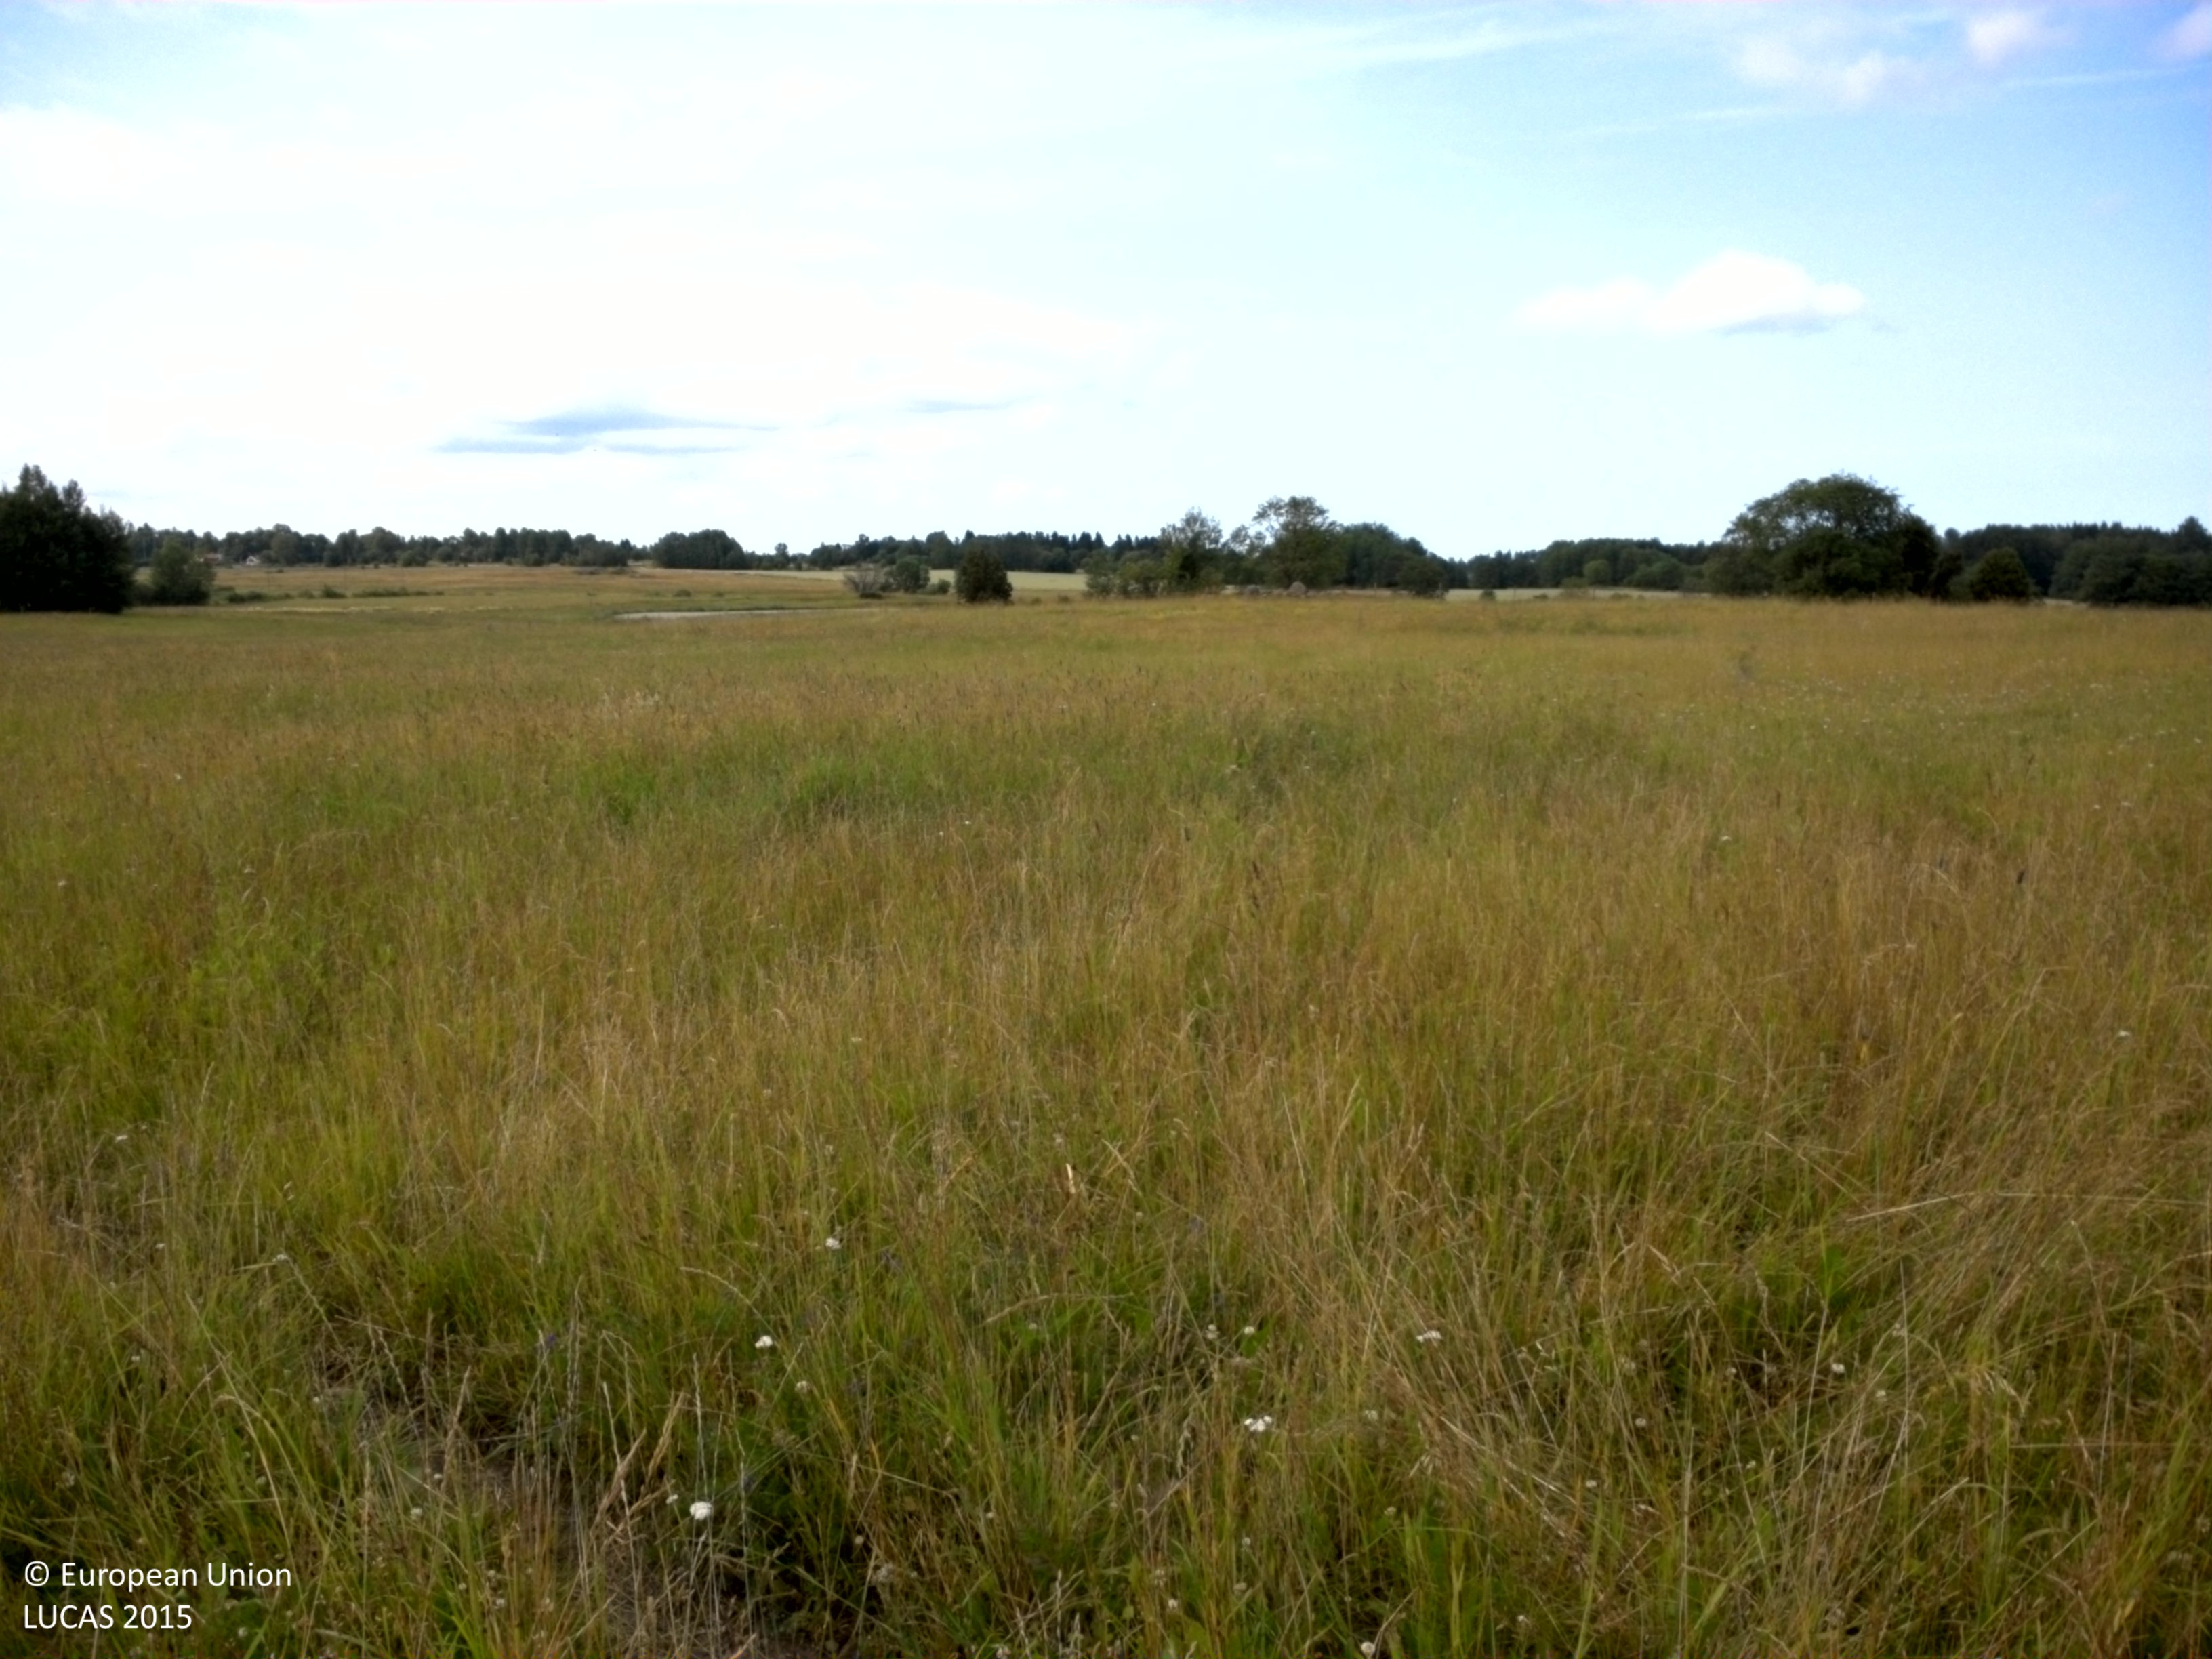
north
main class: Grassland
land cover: Grassland without tree/shrub cover
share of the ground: > 75 %
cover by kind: herbaceous plants 100 %
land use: Agriculture (excluding fallow land and kitchen gardens)
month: July
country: SE
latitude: 59.8398
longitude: 18.6895
